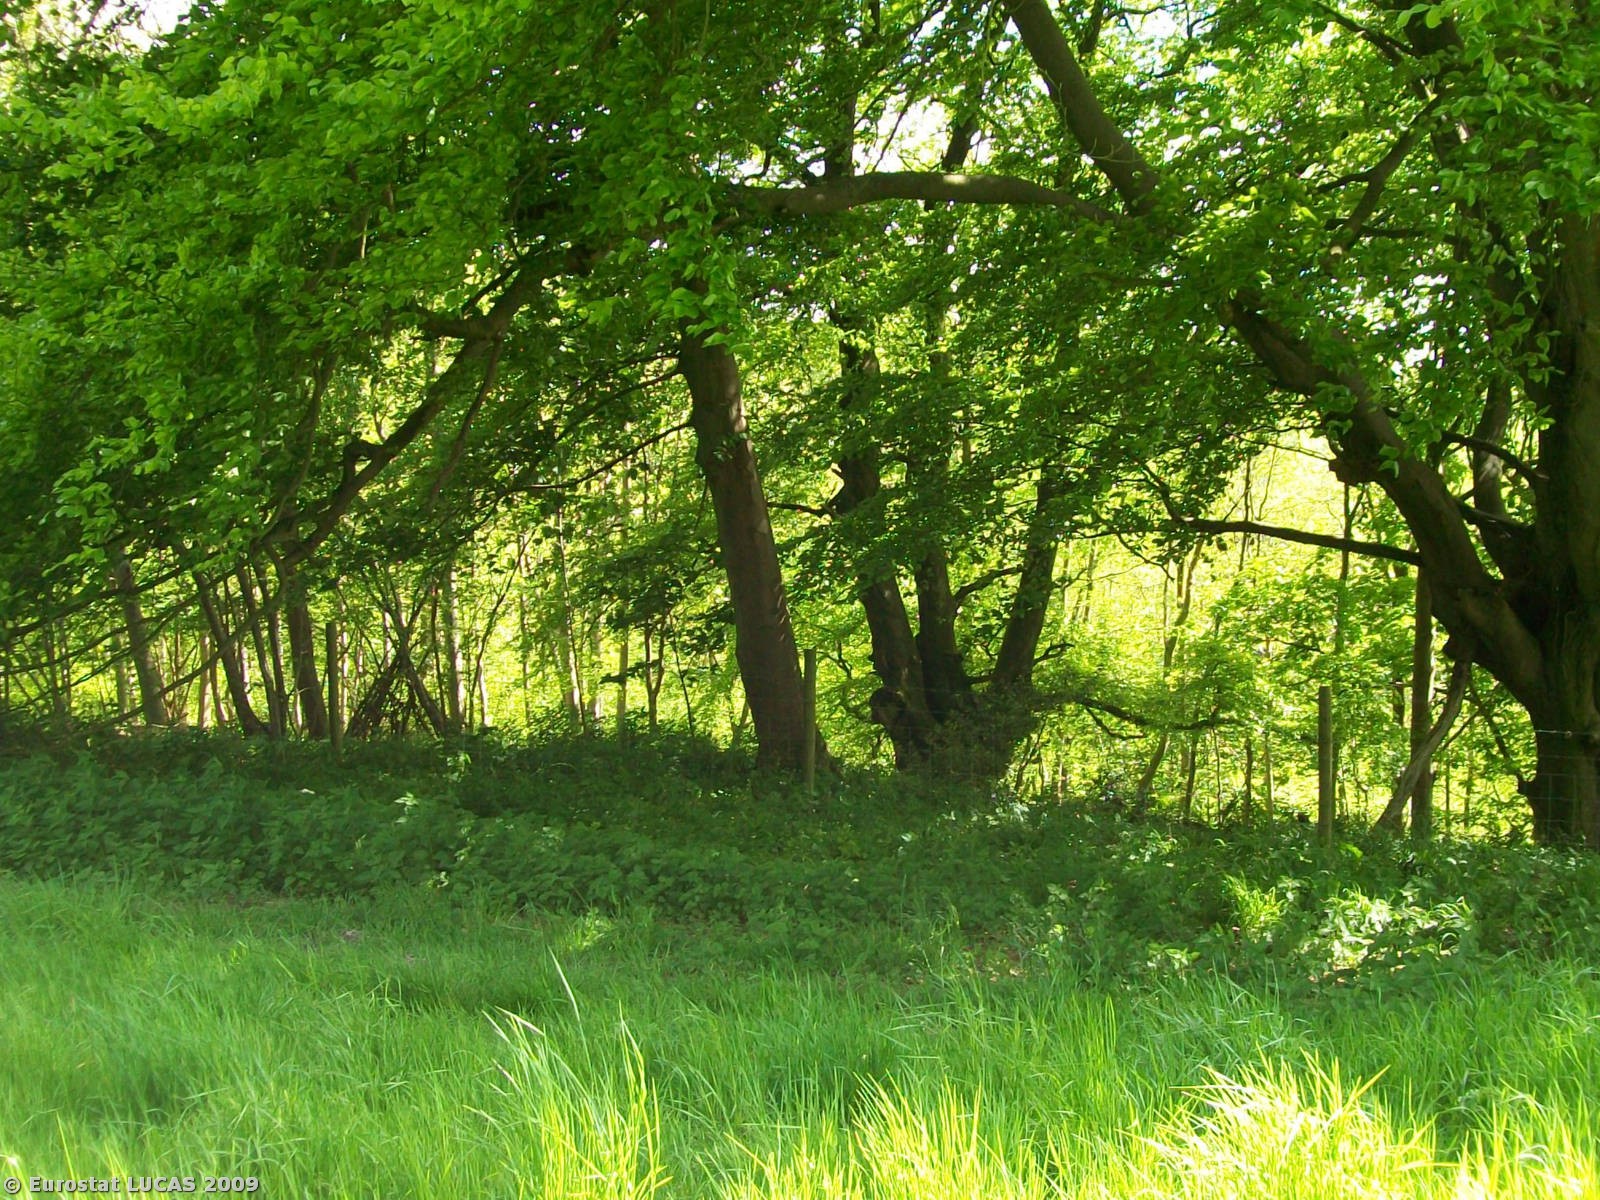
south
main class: Grassland
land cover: Grassland without tree/shrub cover
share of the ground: > 75 %
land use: Agriculture (excluding fallow land and kitchen gardens)
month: May
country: GB
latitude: 51.0775
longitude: -2.1504
